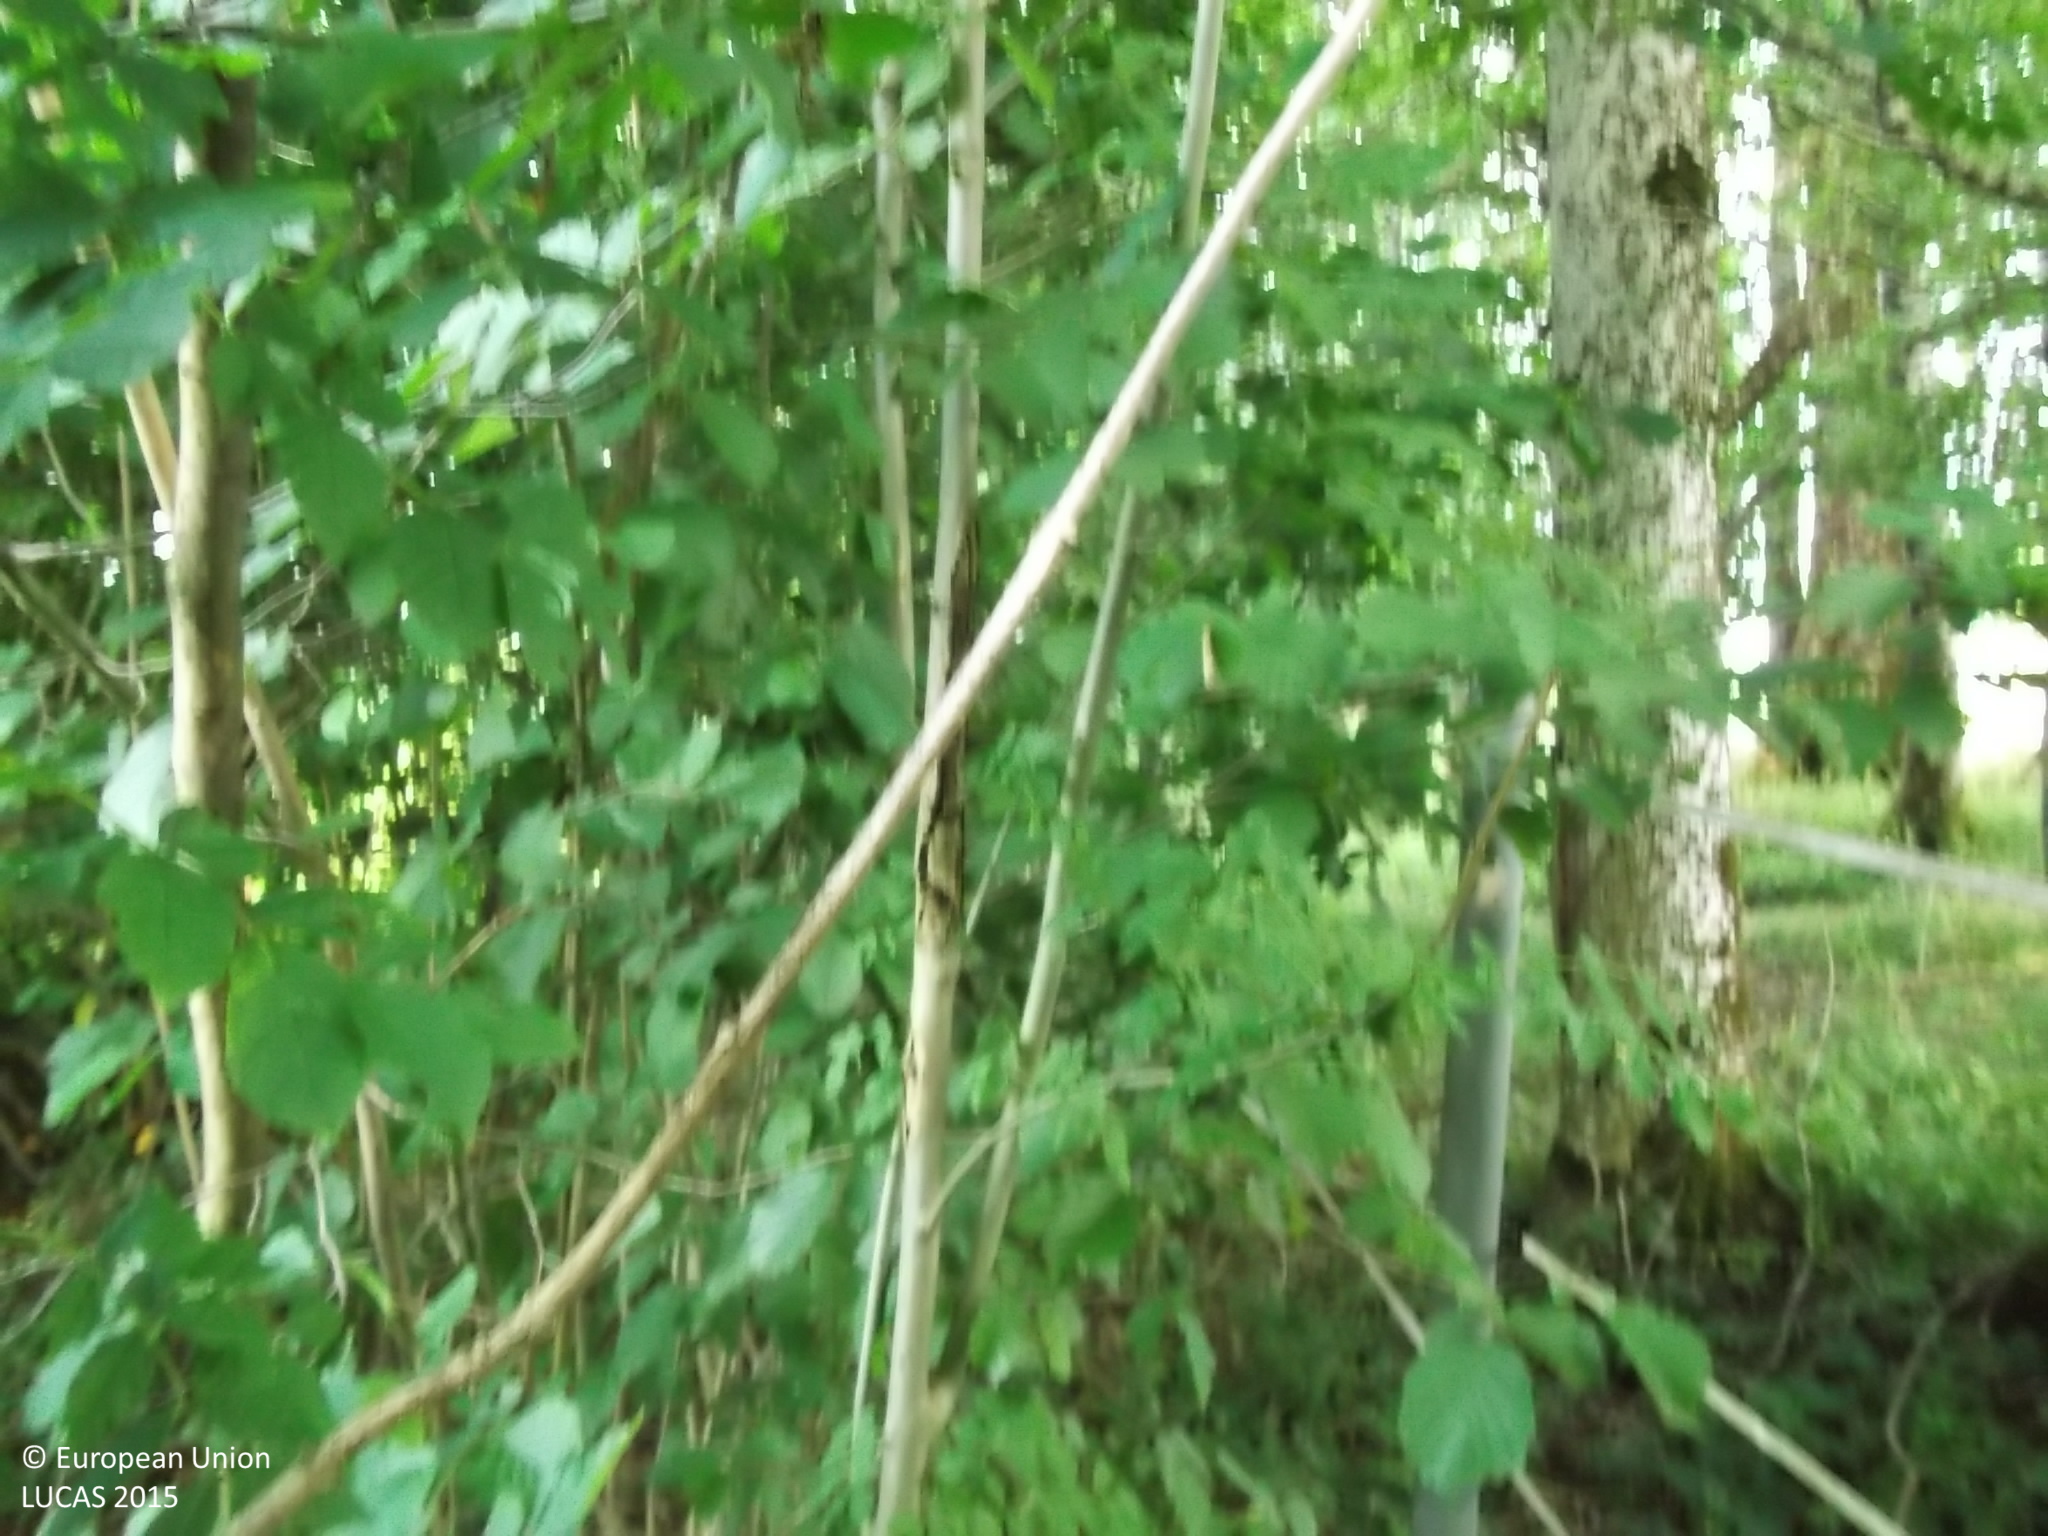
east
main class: Woodland
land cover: Broadleaved woodland
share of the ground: > 75 %
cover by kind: broadleaved forest trees 80 %, coniferous forest trees 10 %, shrubs 5 %, herbaceous plants 5 %
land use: Forestry
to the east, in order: Broadleaved woodland; Fences; Broadleaved woodland; Grassland without tree/shrub cover; Shrubland with sparse tree cover; Fences; Broadleaved woodland; Grassland without tree/shrub cover; Fences; Grassland without tree/shrub cover
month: July
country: AT
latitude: 47.9211
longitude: 13.3310
